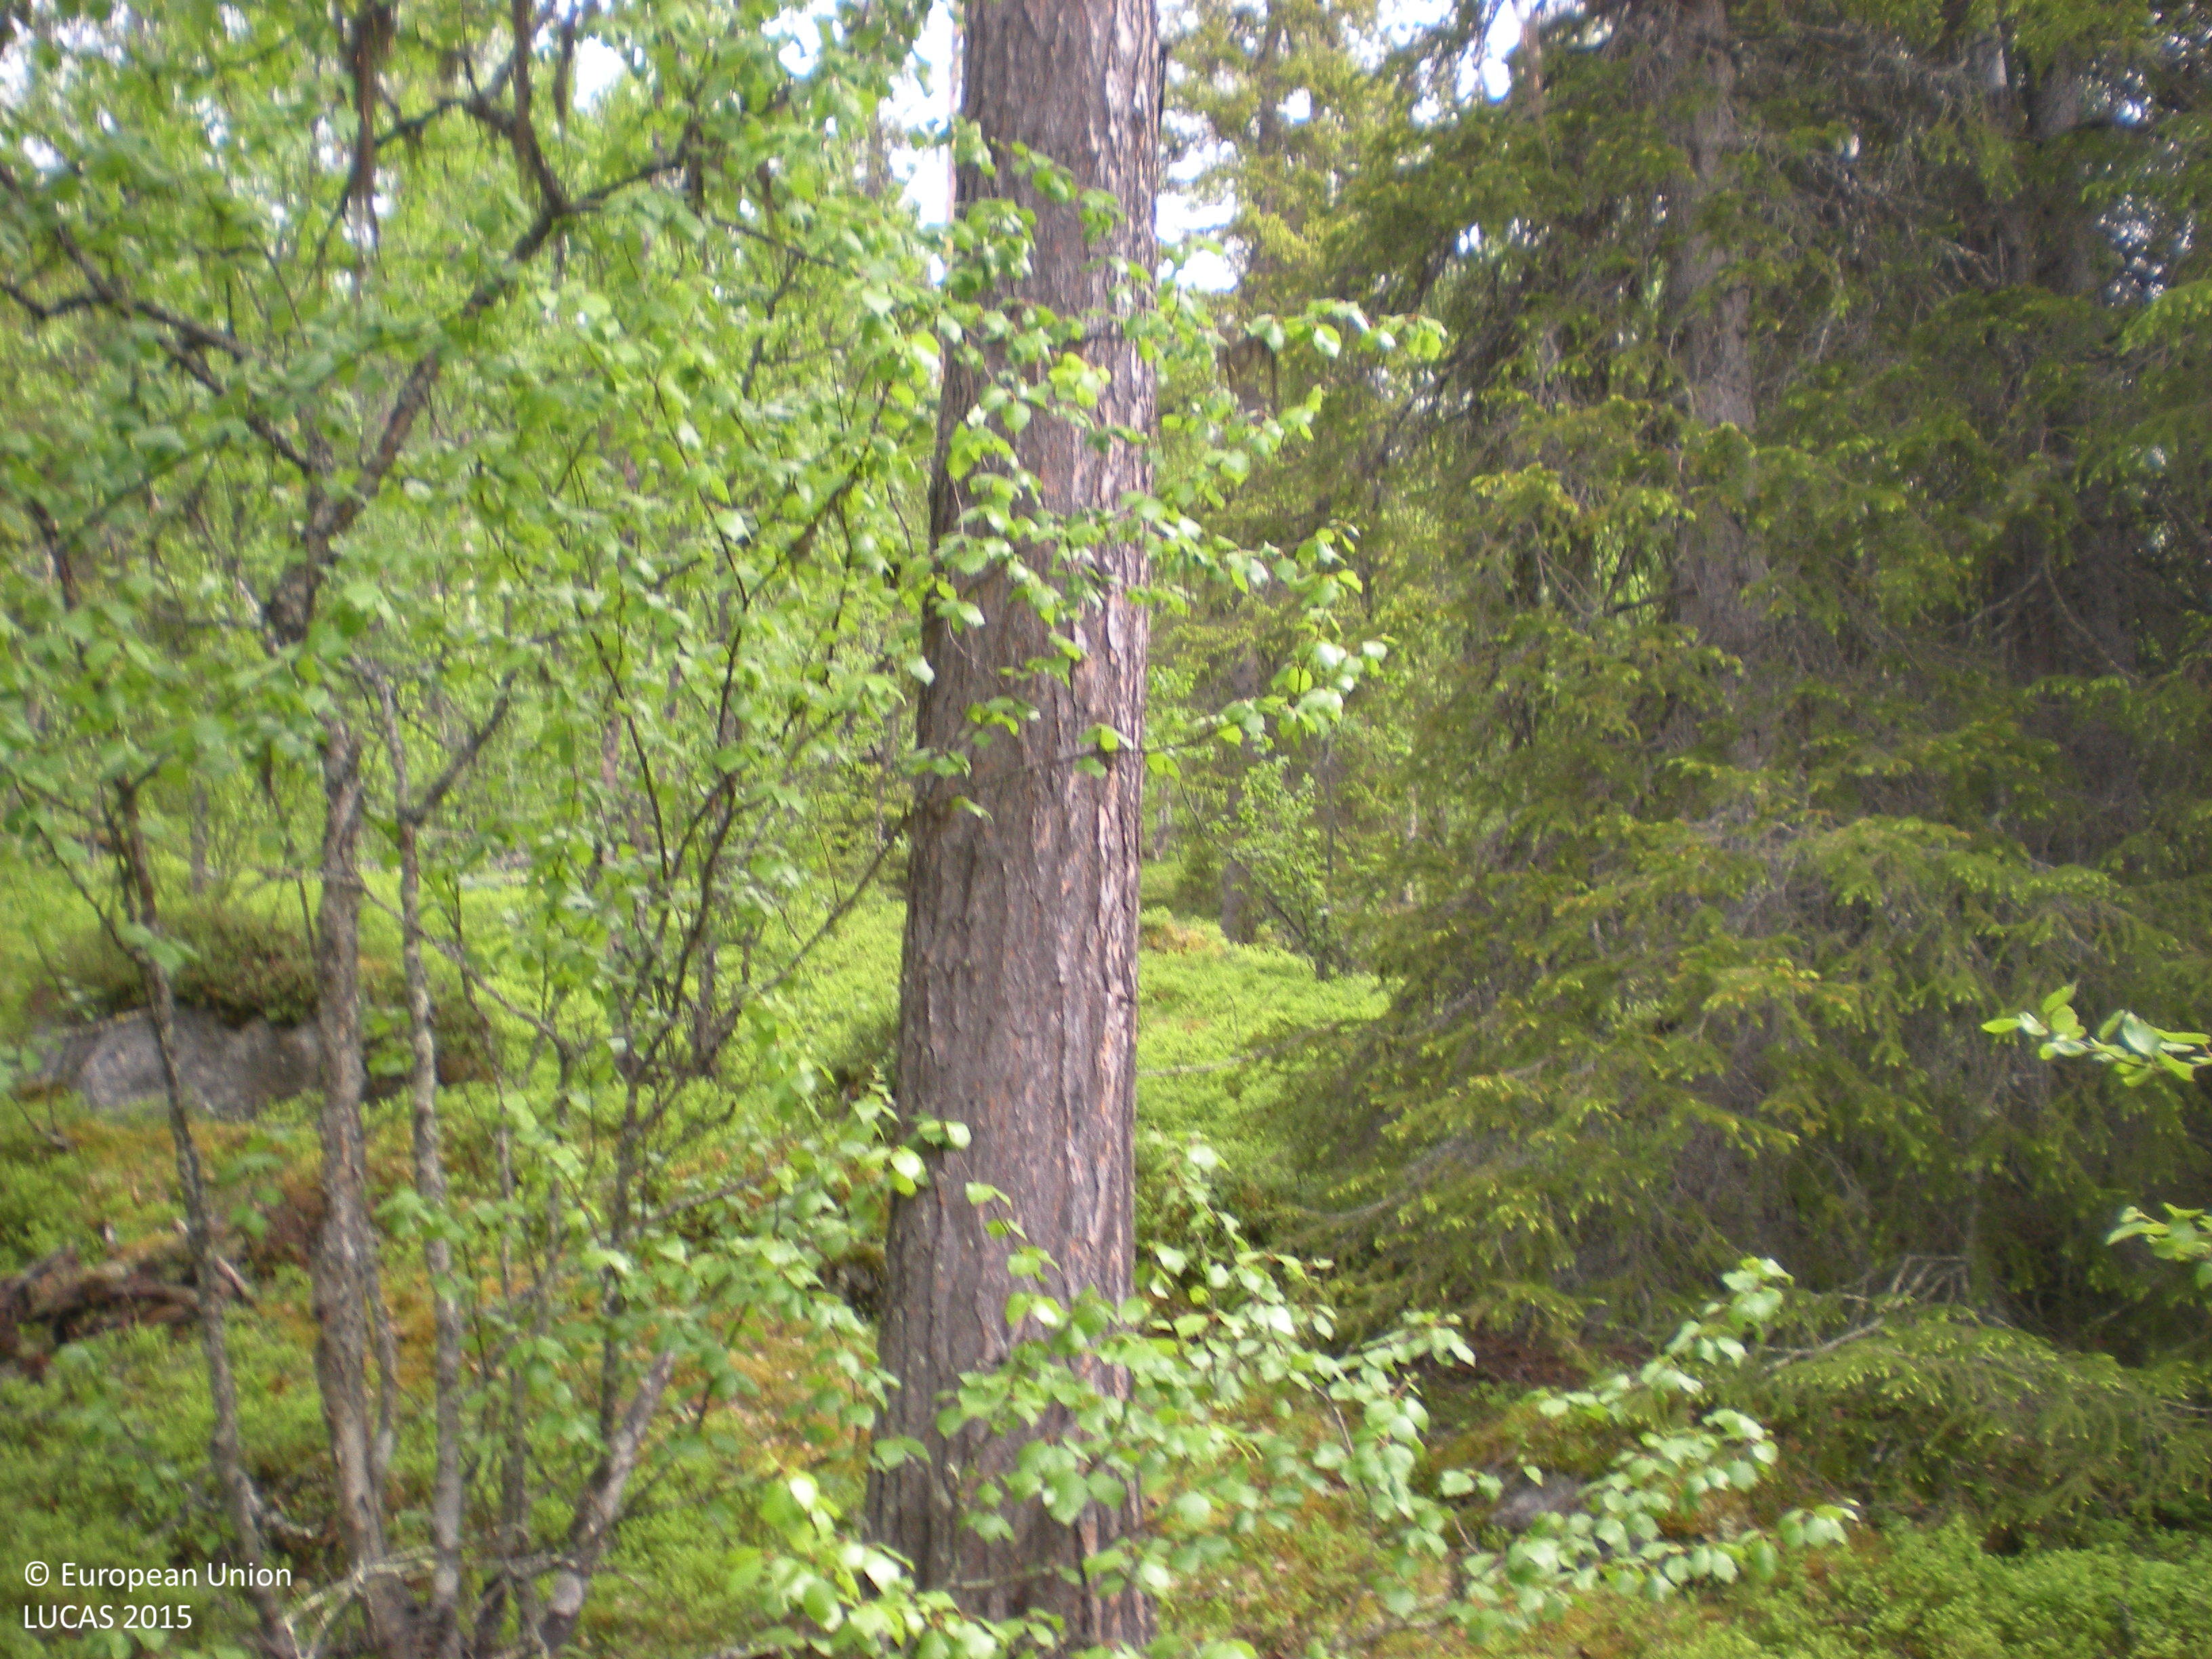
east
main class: Woodland
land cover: Other mixed woodland
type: boreal forest
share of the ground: 50 - 75 %
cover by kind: coniferous forest trees 50 %, broadleaved forest trees 20 %, shrubs 20 %, lichens and mosses 10 %
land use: Forestry
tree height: > 5 m
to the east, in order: Other mixed woodland; Broadleaved woodland
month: July
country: SE
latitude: 66.1611
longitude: 17.1615
